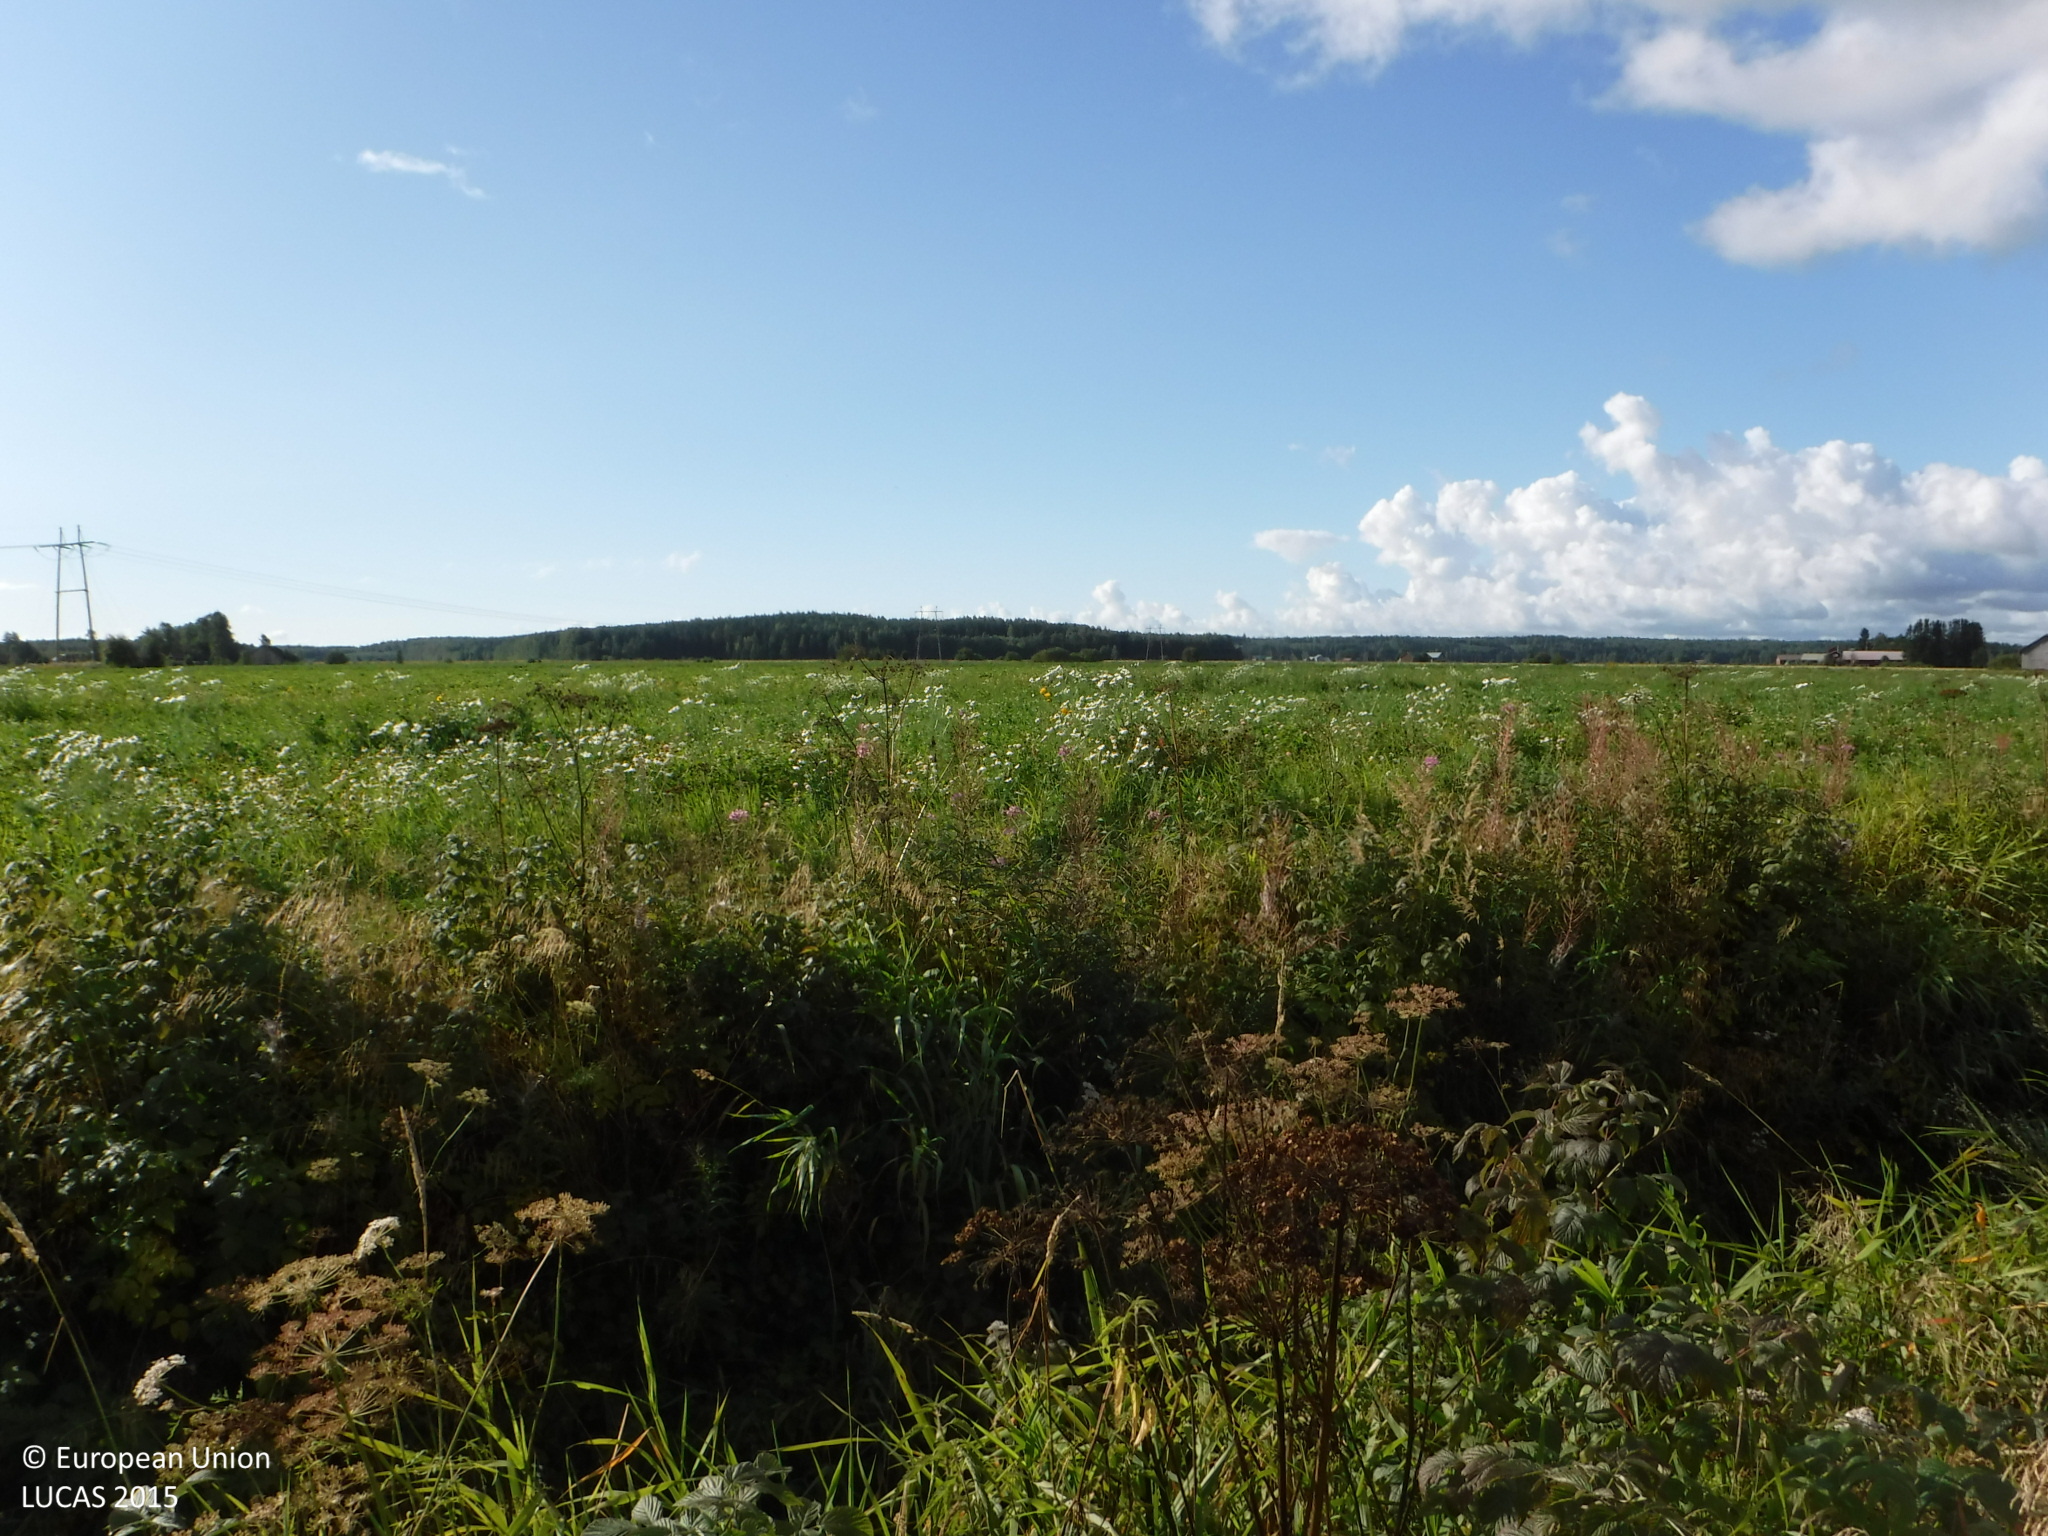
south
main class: Cropland
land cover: Common wheat
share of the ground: > 75 %
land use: Agriculture (excluding fallow land and kitchen gardens)
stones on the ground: < 10 %
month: August
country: FI
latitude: 61.3271
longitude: 21.9963
